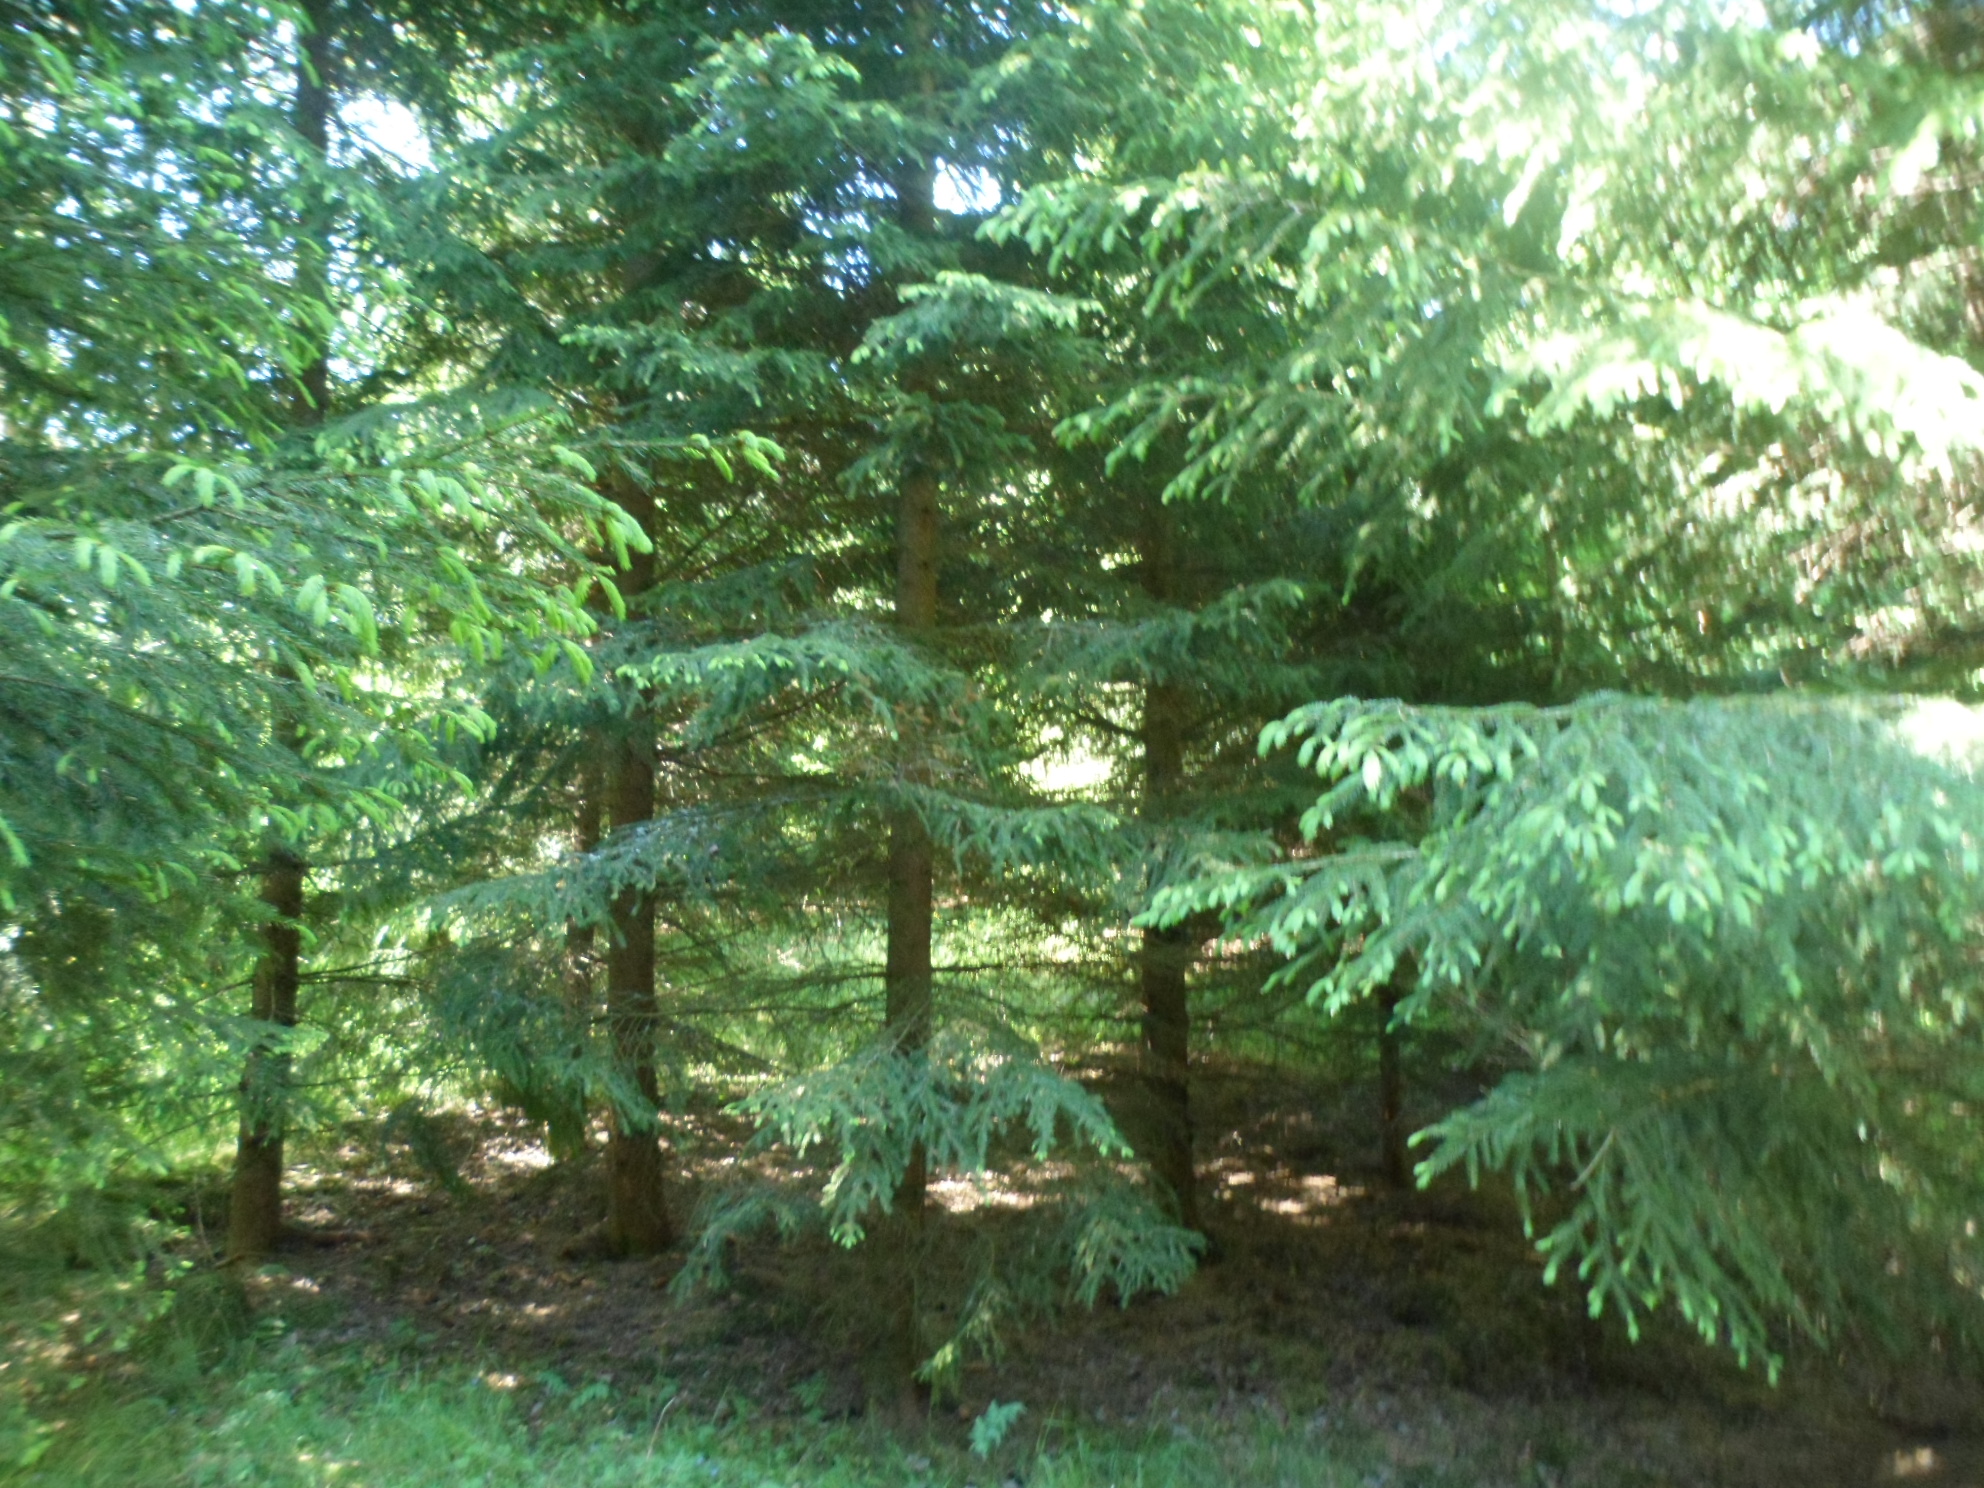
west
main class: Woodland
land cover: Spruce dominated coniferous woodland
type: boreal forest
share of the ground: > 75 %
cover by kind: coniferous forest trees 75 %, herbaceous plants 15 %, lichens and mosses 10 %
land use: Forestry
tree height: > 5 m
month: July
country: SE
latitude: 57.4534
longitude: 14.6790
